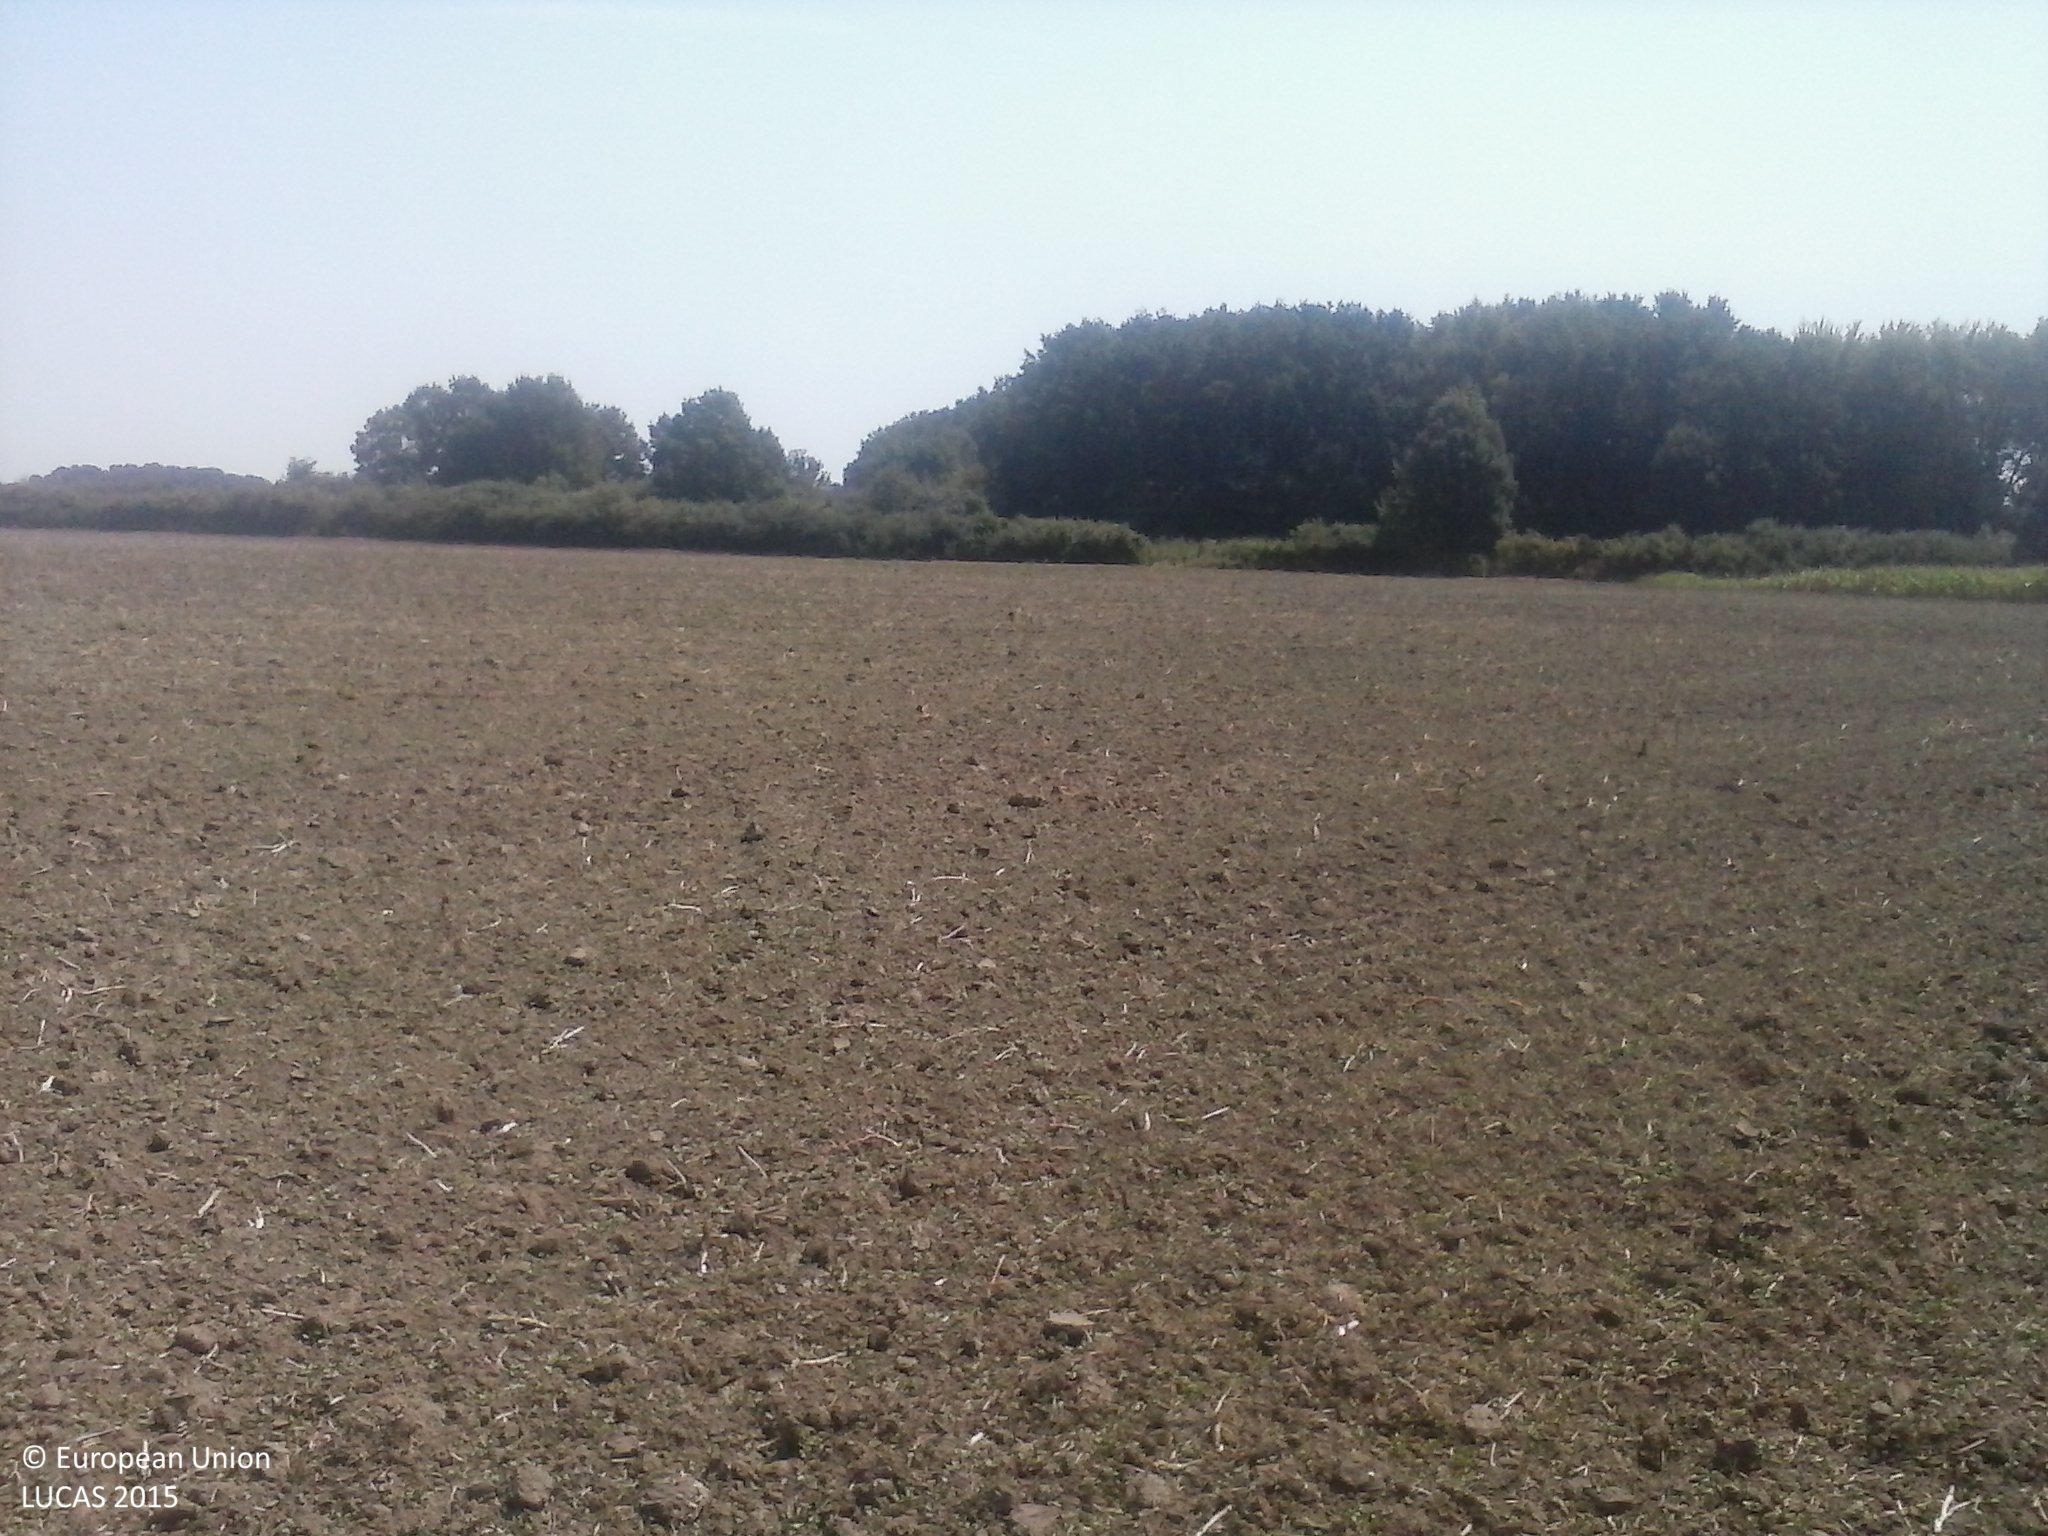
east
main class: Cropland
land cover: Maize
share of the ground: > 75 %
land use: Agriculture (excluding fallow land and kitchen gardens)
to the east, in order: Maize; Other bare soil
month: August
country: HU
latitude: 46.0189
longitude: 17.9493
